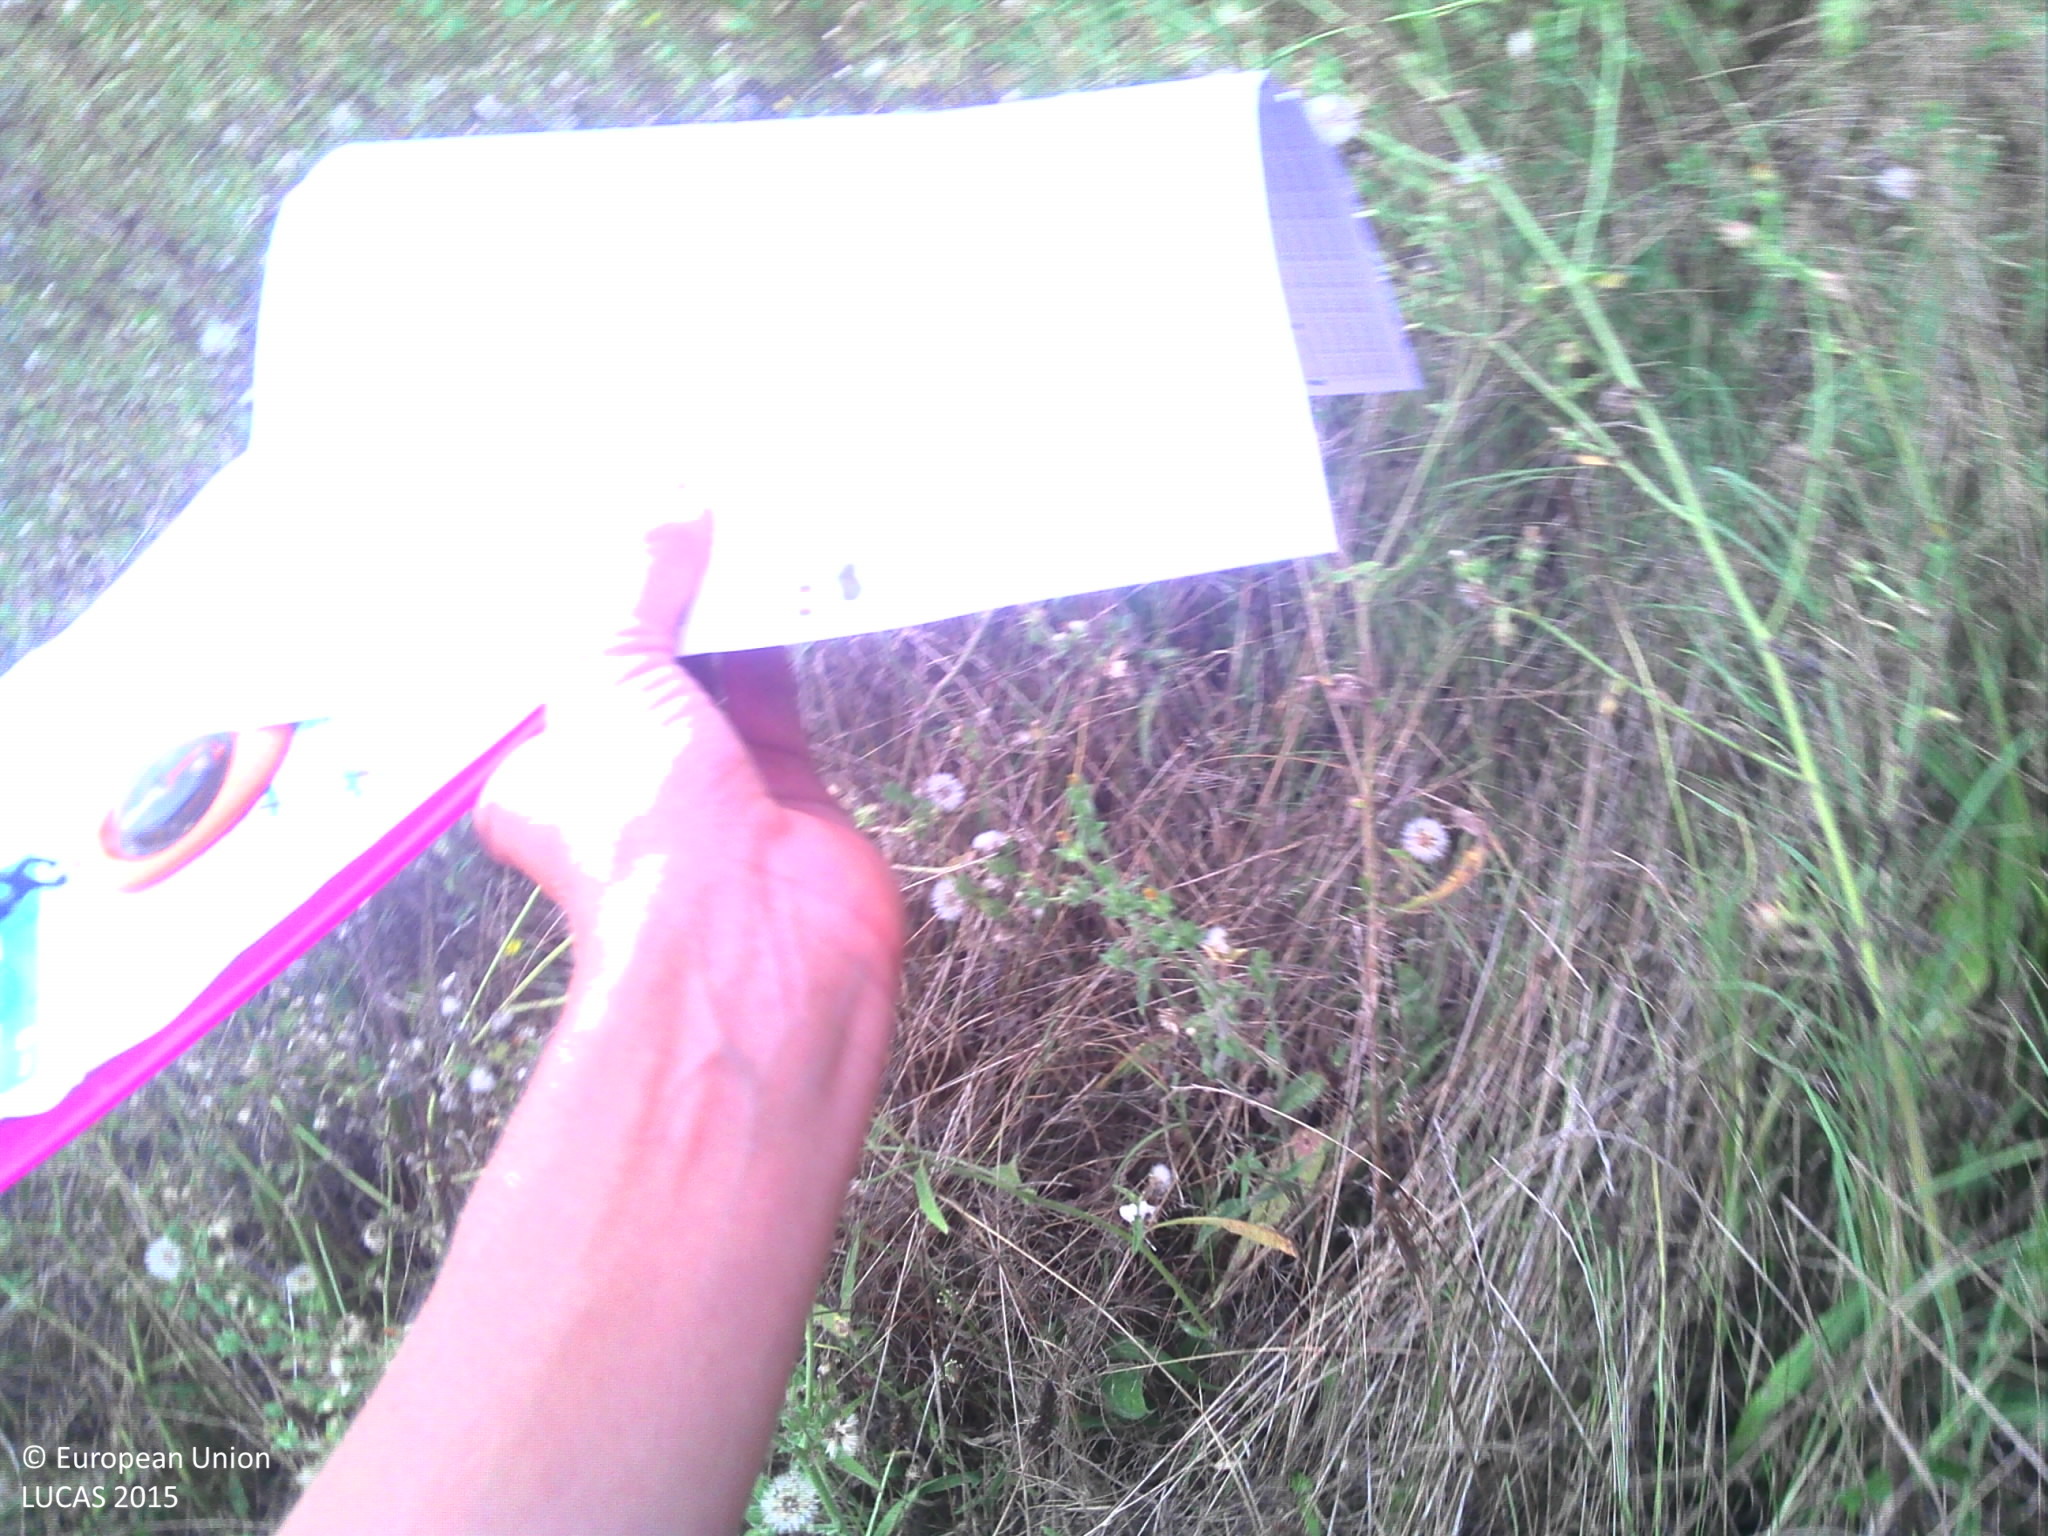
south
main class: Grassland
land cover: Spontaneously vegetated surfaces
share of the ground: > 75 %
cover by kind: herbaceous plants 100 %
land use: Fallow land
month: August
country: FR
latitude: 43.9359
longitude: 1.3674
